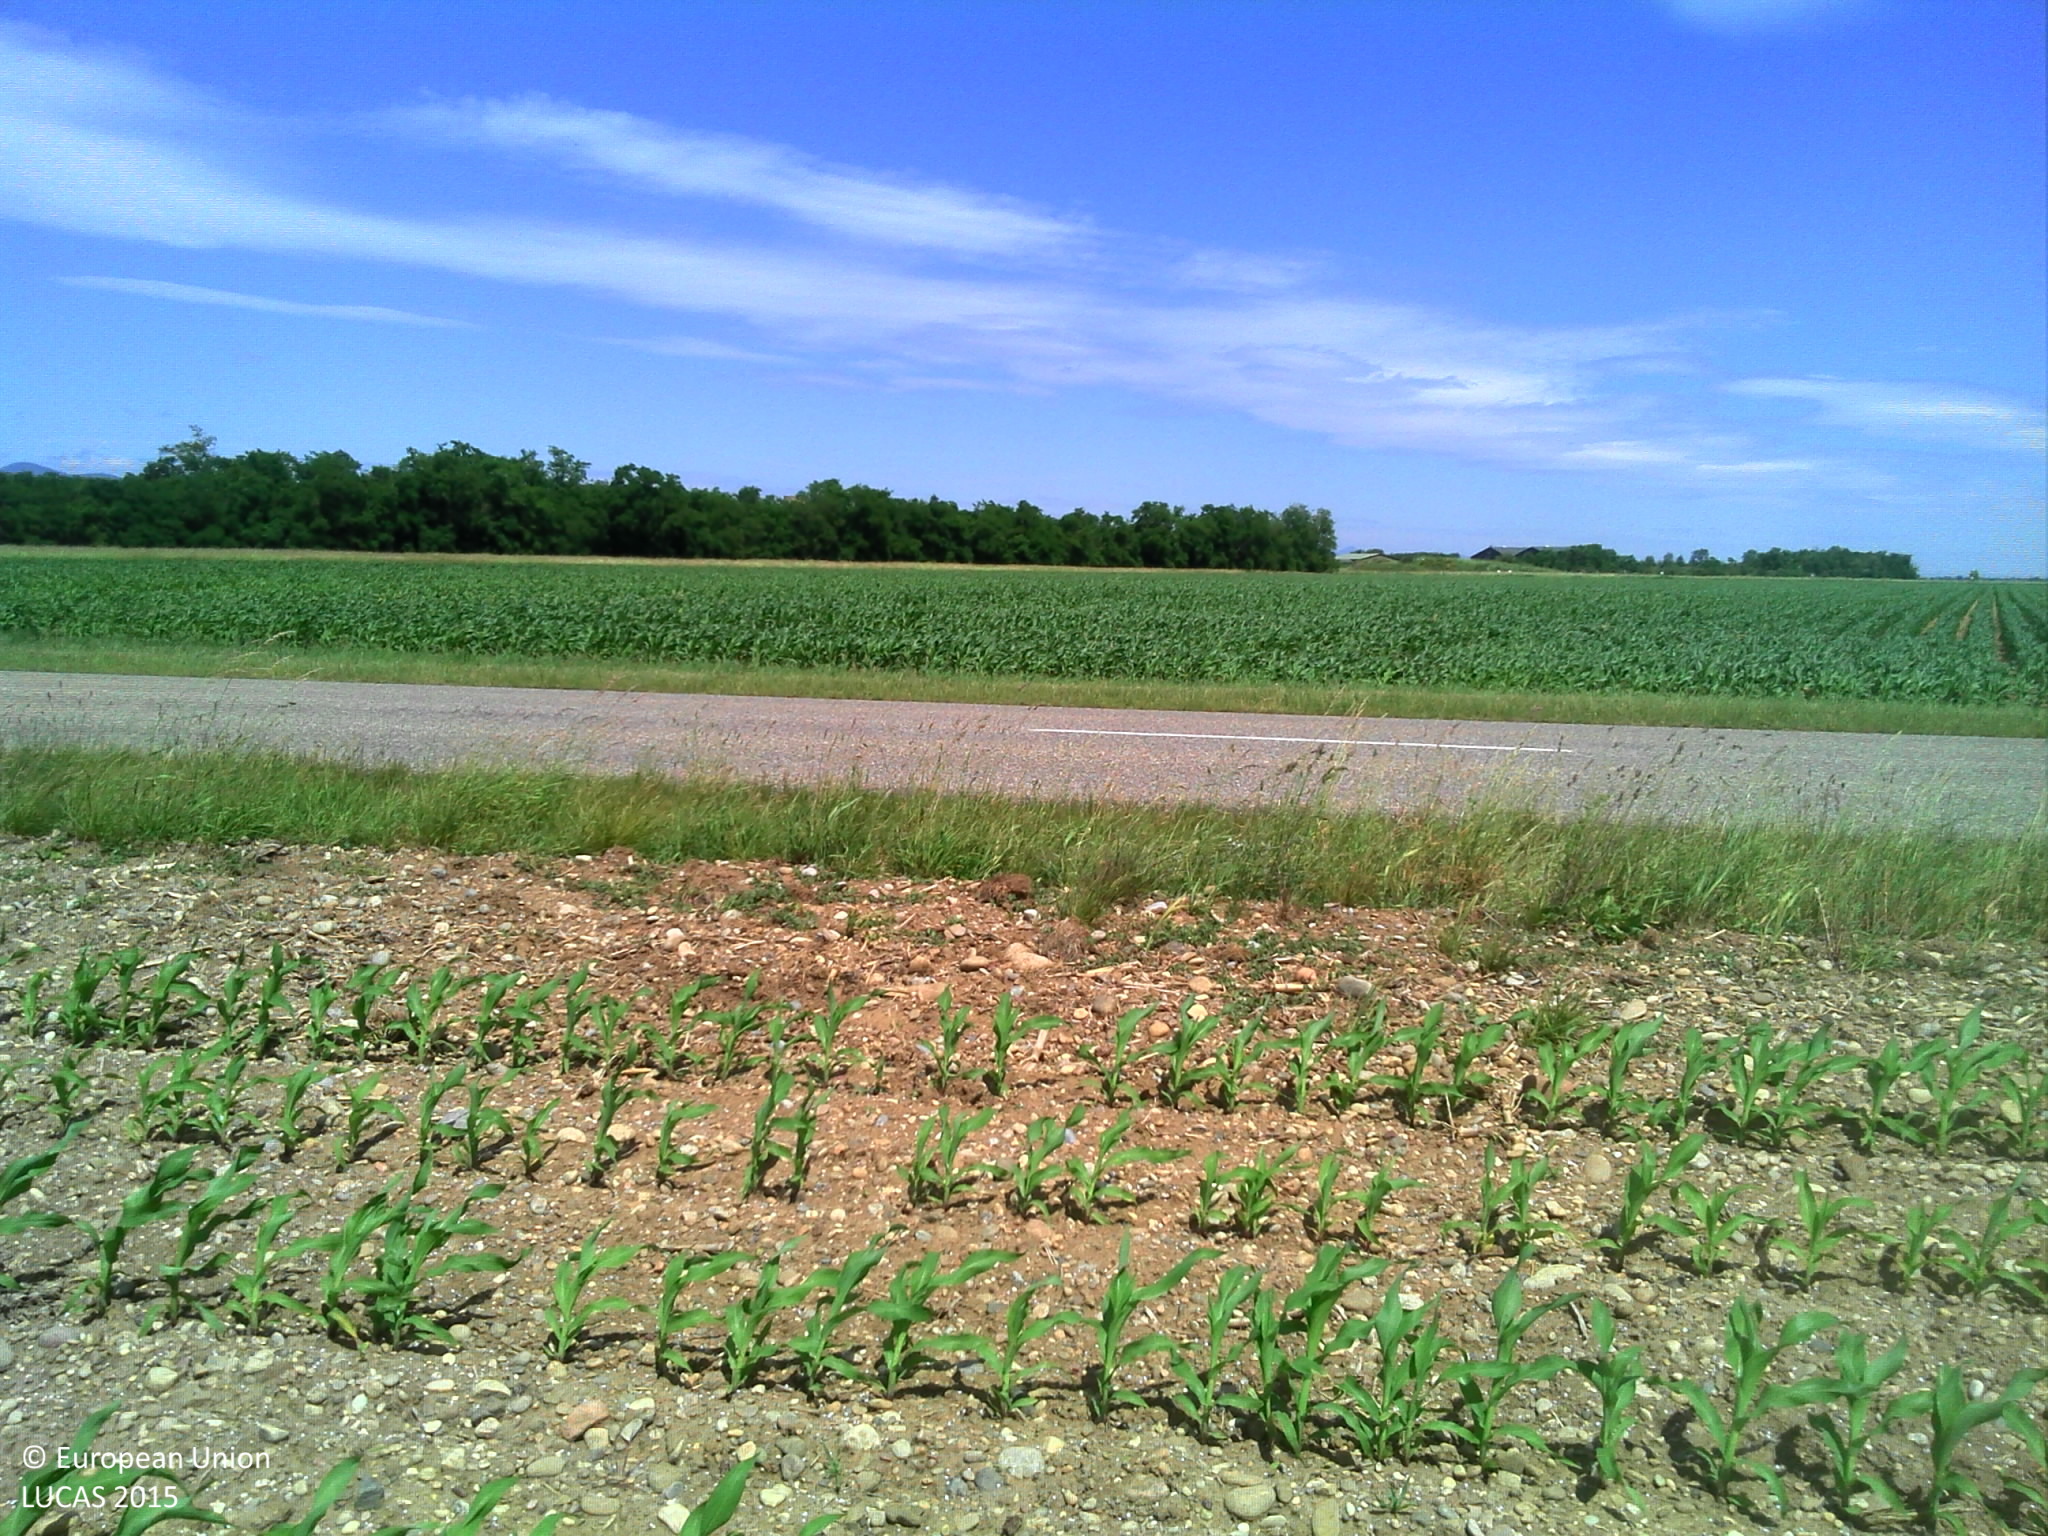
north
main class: Cropland
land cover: Maize
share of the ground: < 10 %
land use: Agriculture (excluding fallow land and kitchen gardens)
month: June
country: FR
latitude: 47.9046
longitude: 7.3926
